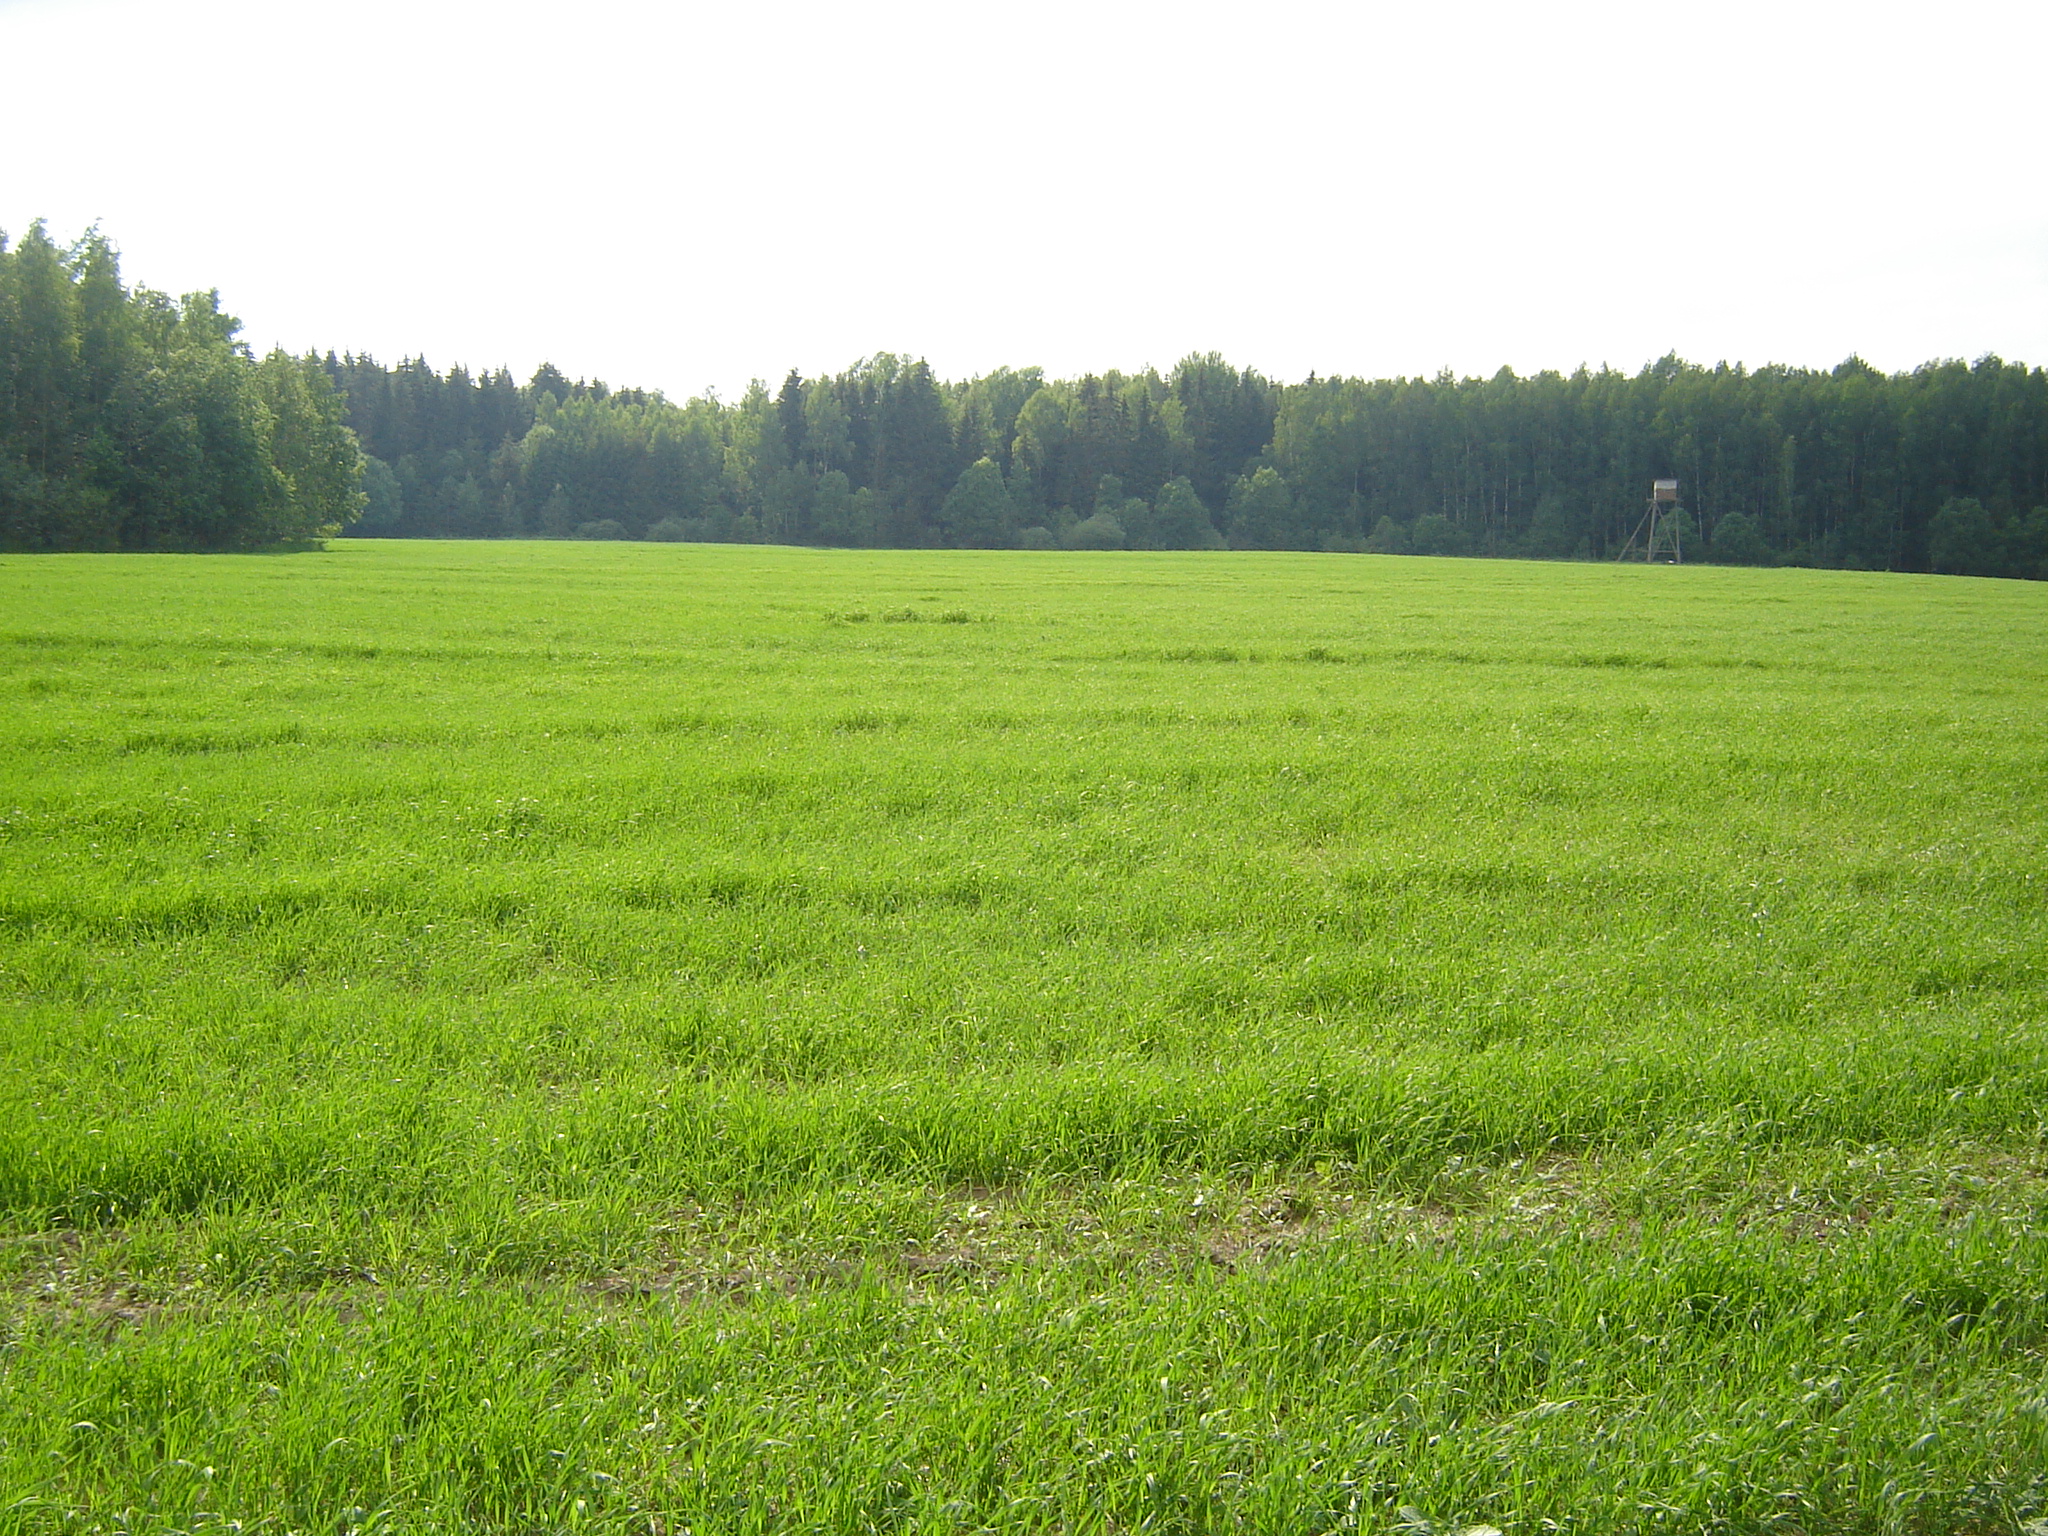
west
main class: Cropland
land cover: Common wheat
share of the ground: > 75 %
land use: Agriculture (excluding fallow land and kitchen gardens)
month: June
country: LT
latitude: 55.8870
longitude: 25.2902
